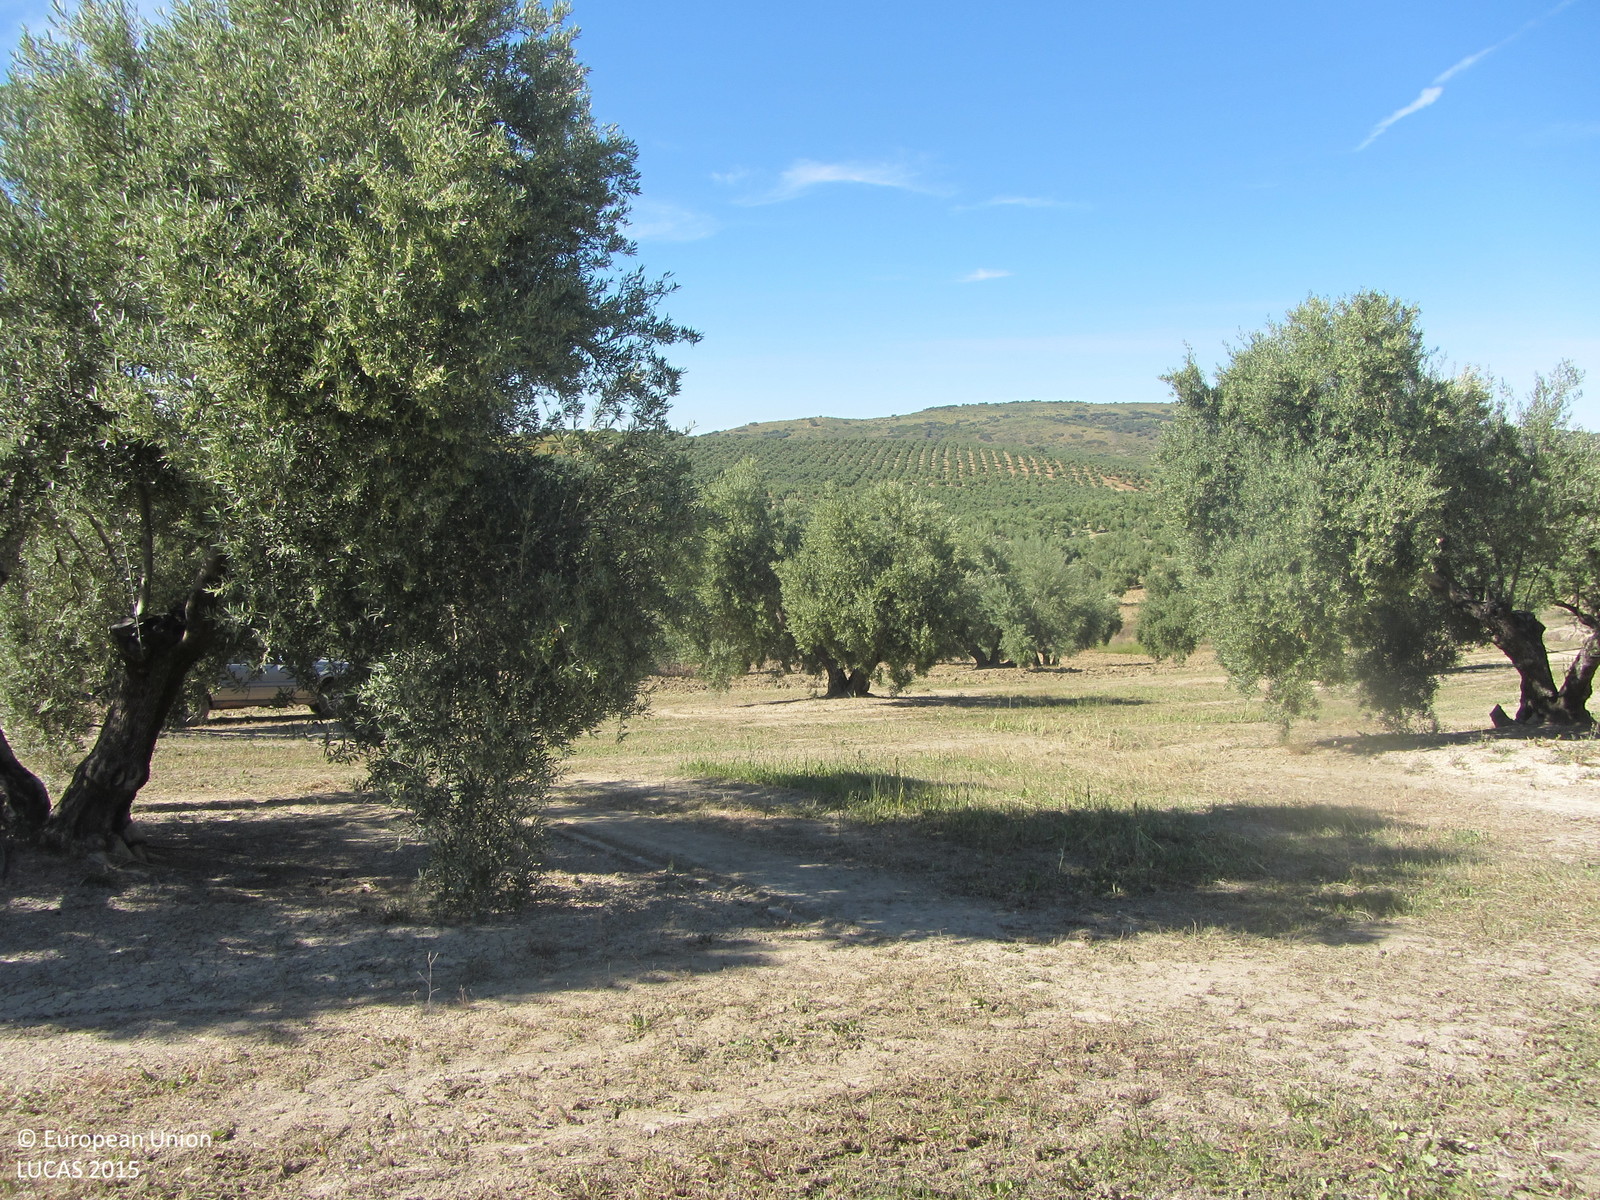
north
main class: Cropland
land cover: Olive groves
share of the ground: 25 - 50 %
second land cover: Spontaneously vegetated surfaces
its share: 50 - 75 %
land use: Agriculture (excluding fallow land and kitchen gardens)
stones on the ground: < 10 %
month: May
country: ES
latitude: 38.0763
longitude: -3.4190
